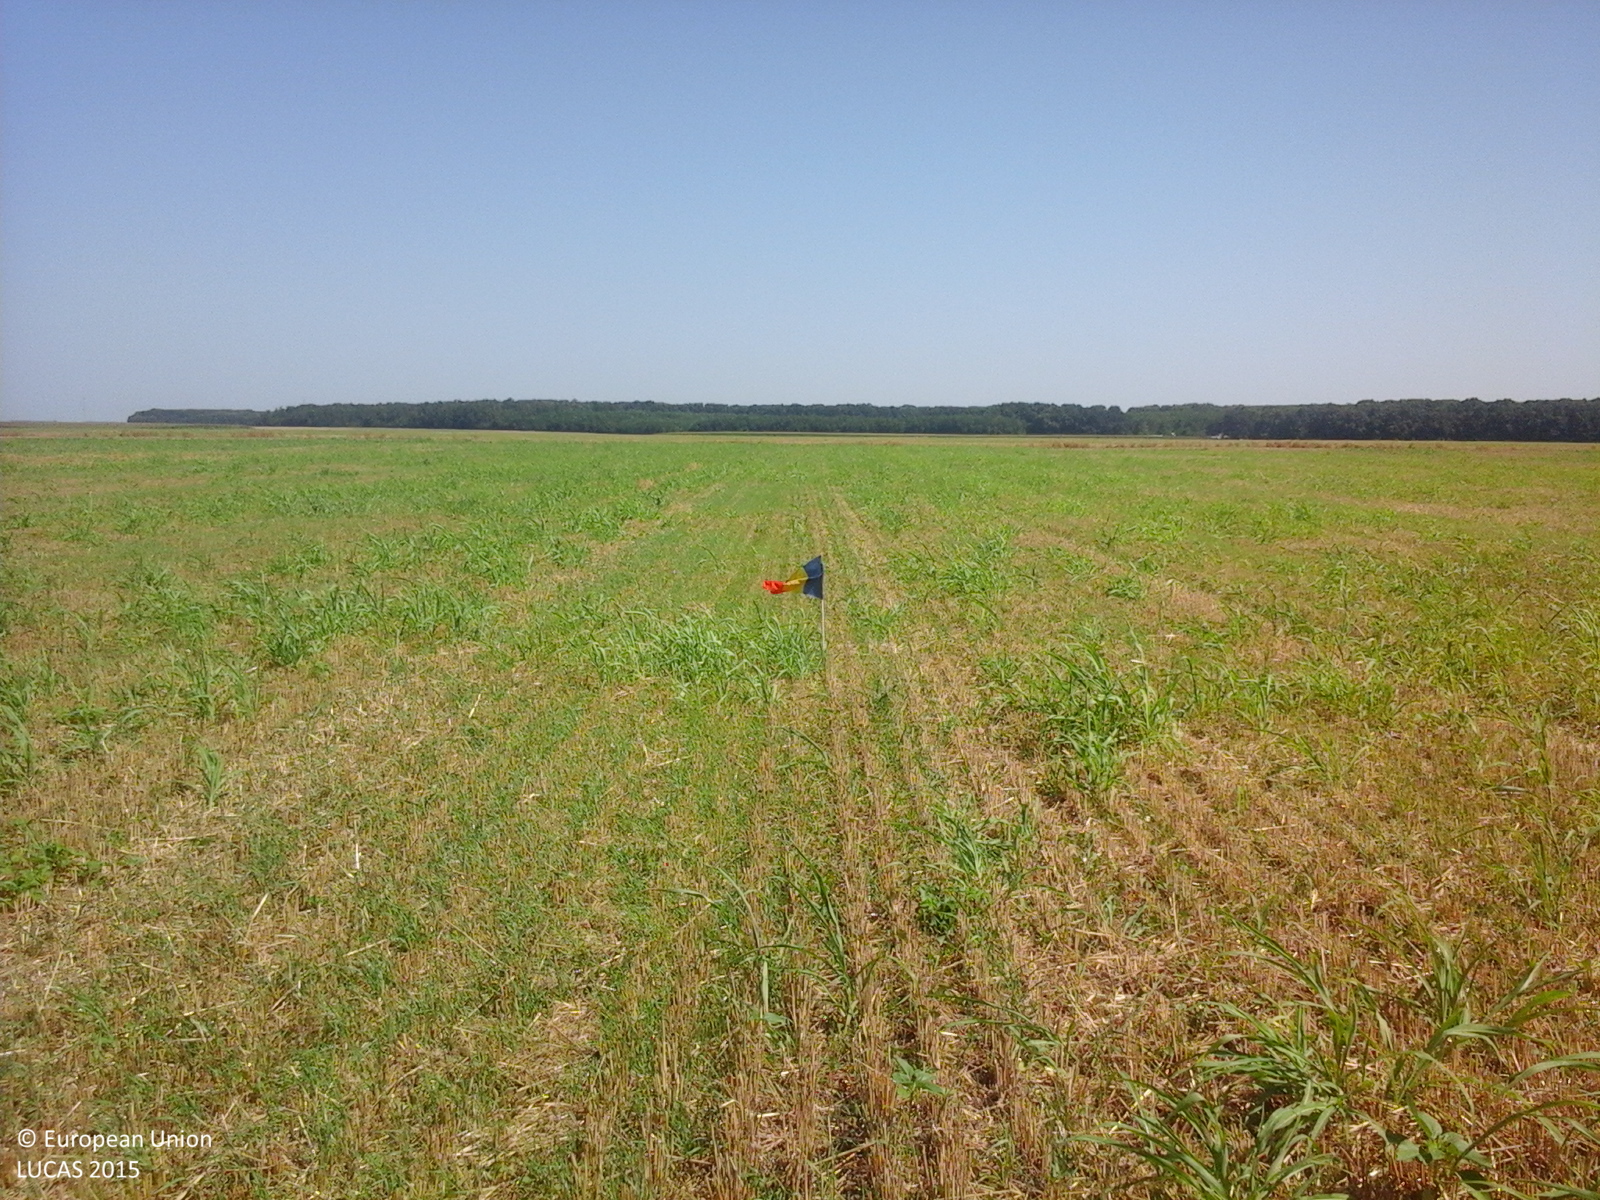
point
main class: Cropland
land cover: Common wheat
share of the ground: 50 - 75 %
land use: Agriculture (excluding fallow land and kitchen gardens)
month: July
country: RO
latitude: 44.3797
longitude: 26.4935
